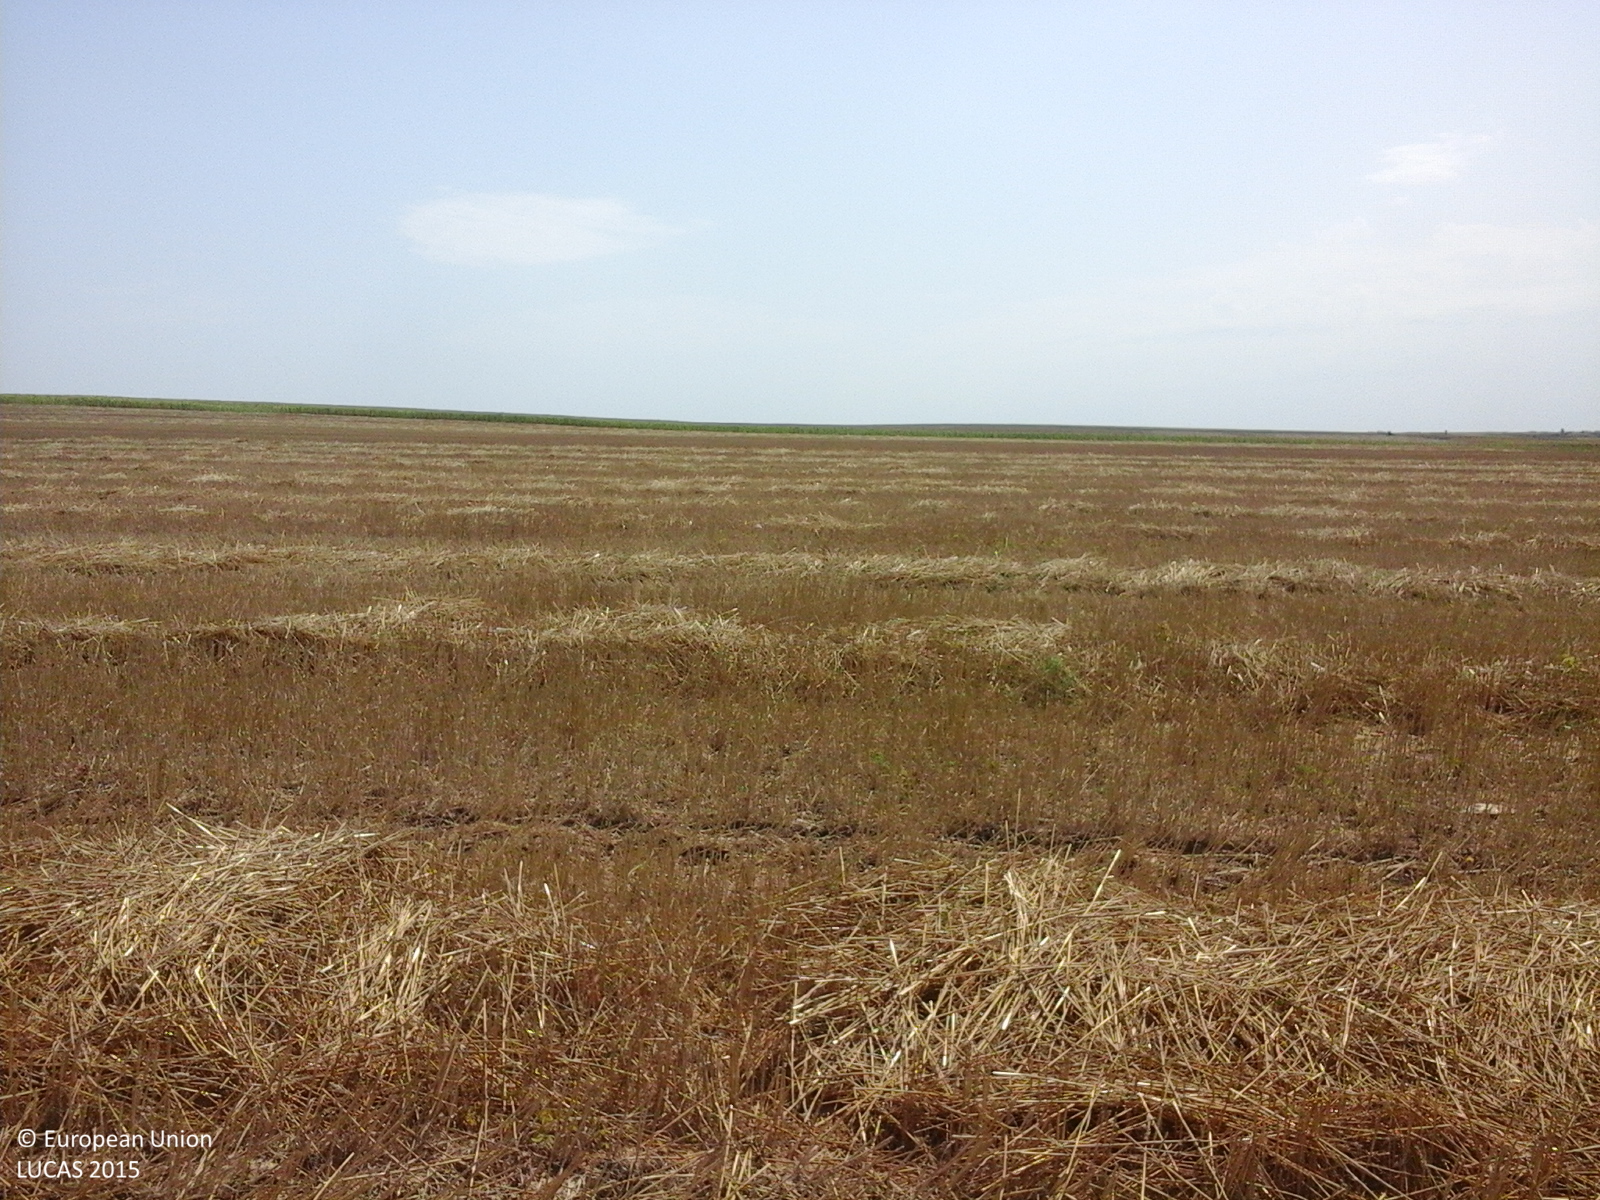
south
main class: Cropland
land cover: Common wheat
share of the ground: > 75 %
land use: Agriculture (excluding fallow land and kitchen gardens)
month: August
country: RO
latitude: 43.7836
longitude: 28.2616
